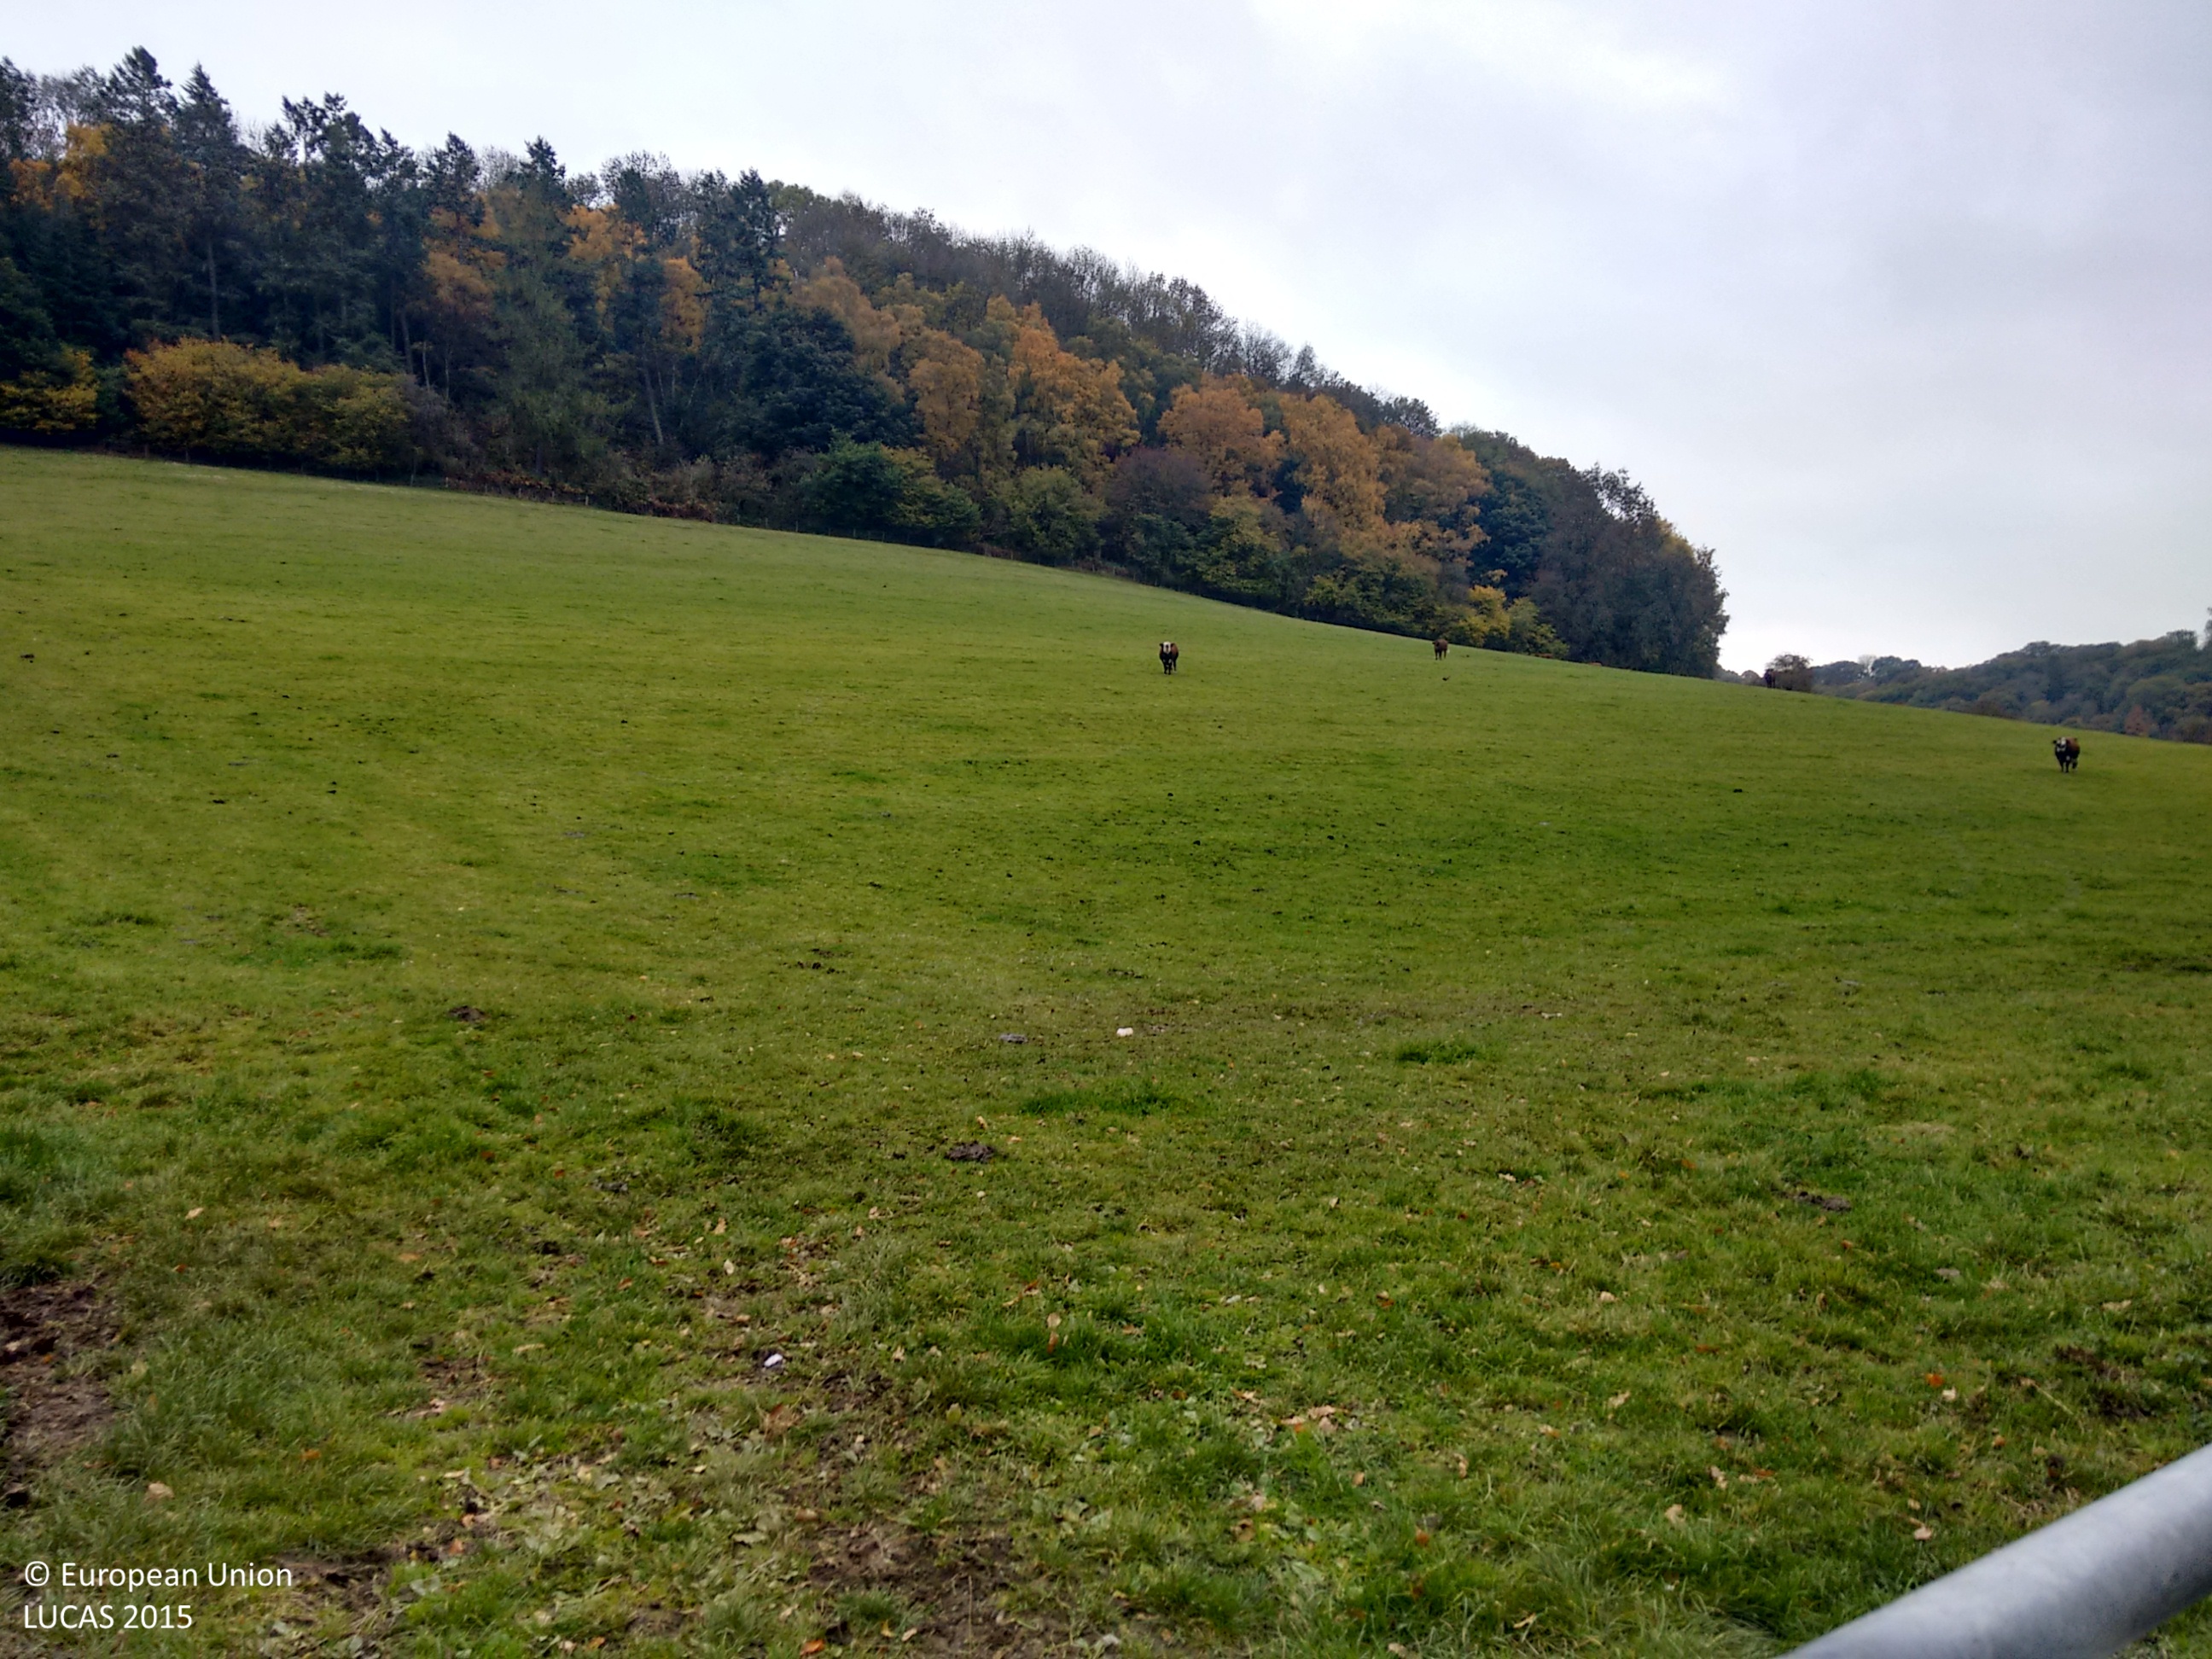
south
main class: Grassland
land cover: Grassland without tree/shrub cover
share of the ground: > 75 %
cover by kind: herbaceous plants 100 %
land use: Agriculture (excluding fallow land and kitchen gardens)
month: October
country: GB
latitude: 52.4669
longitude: -2.7741
